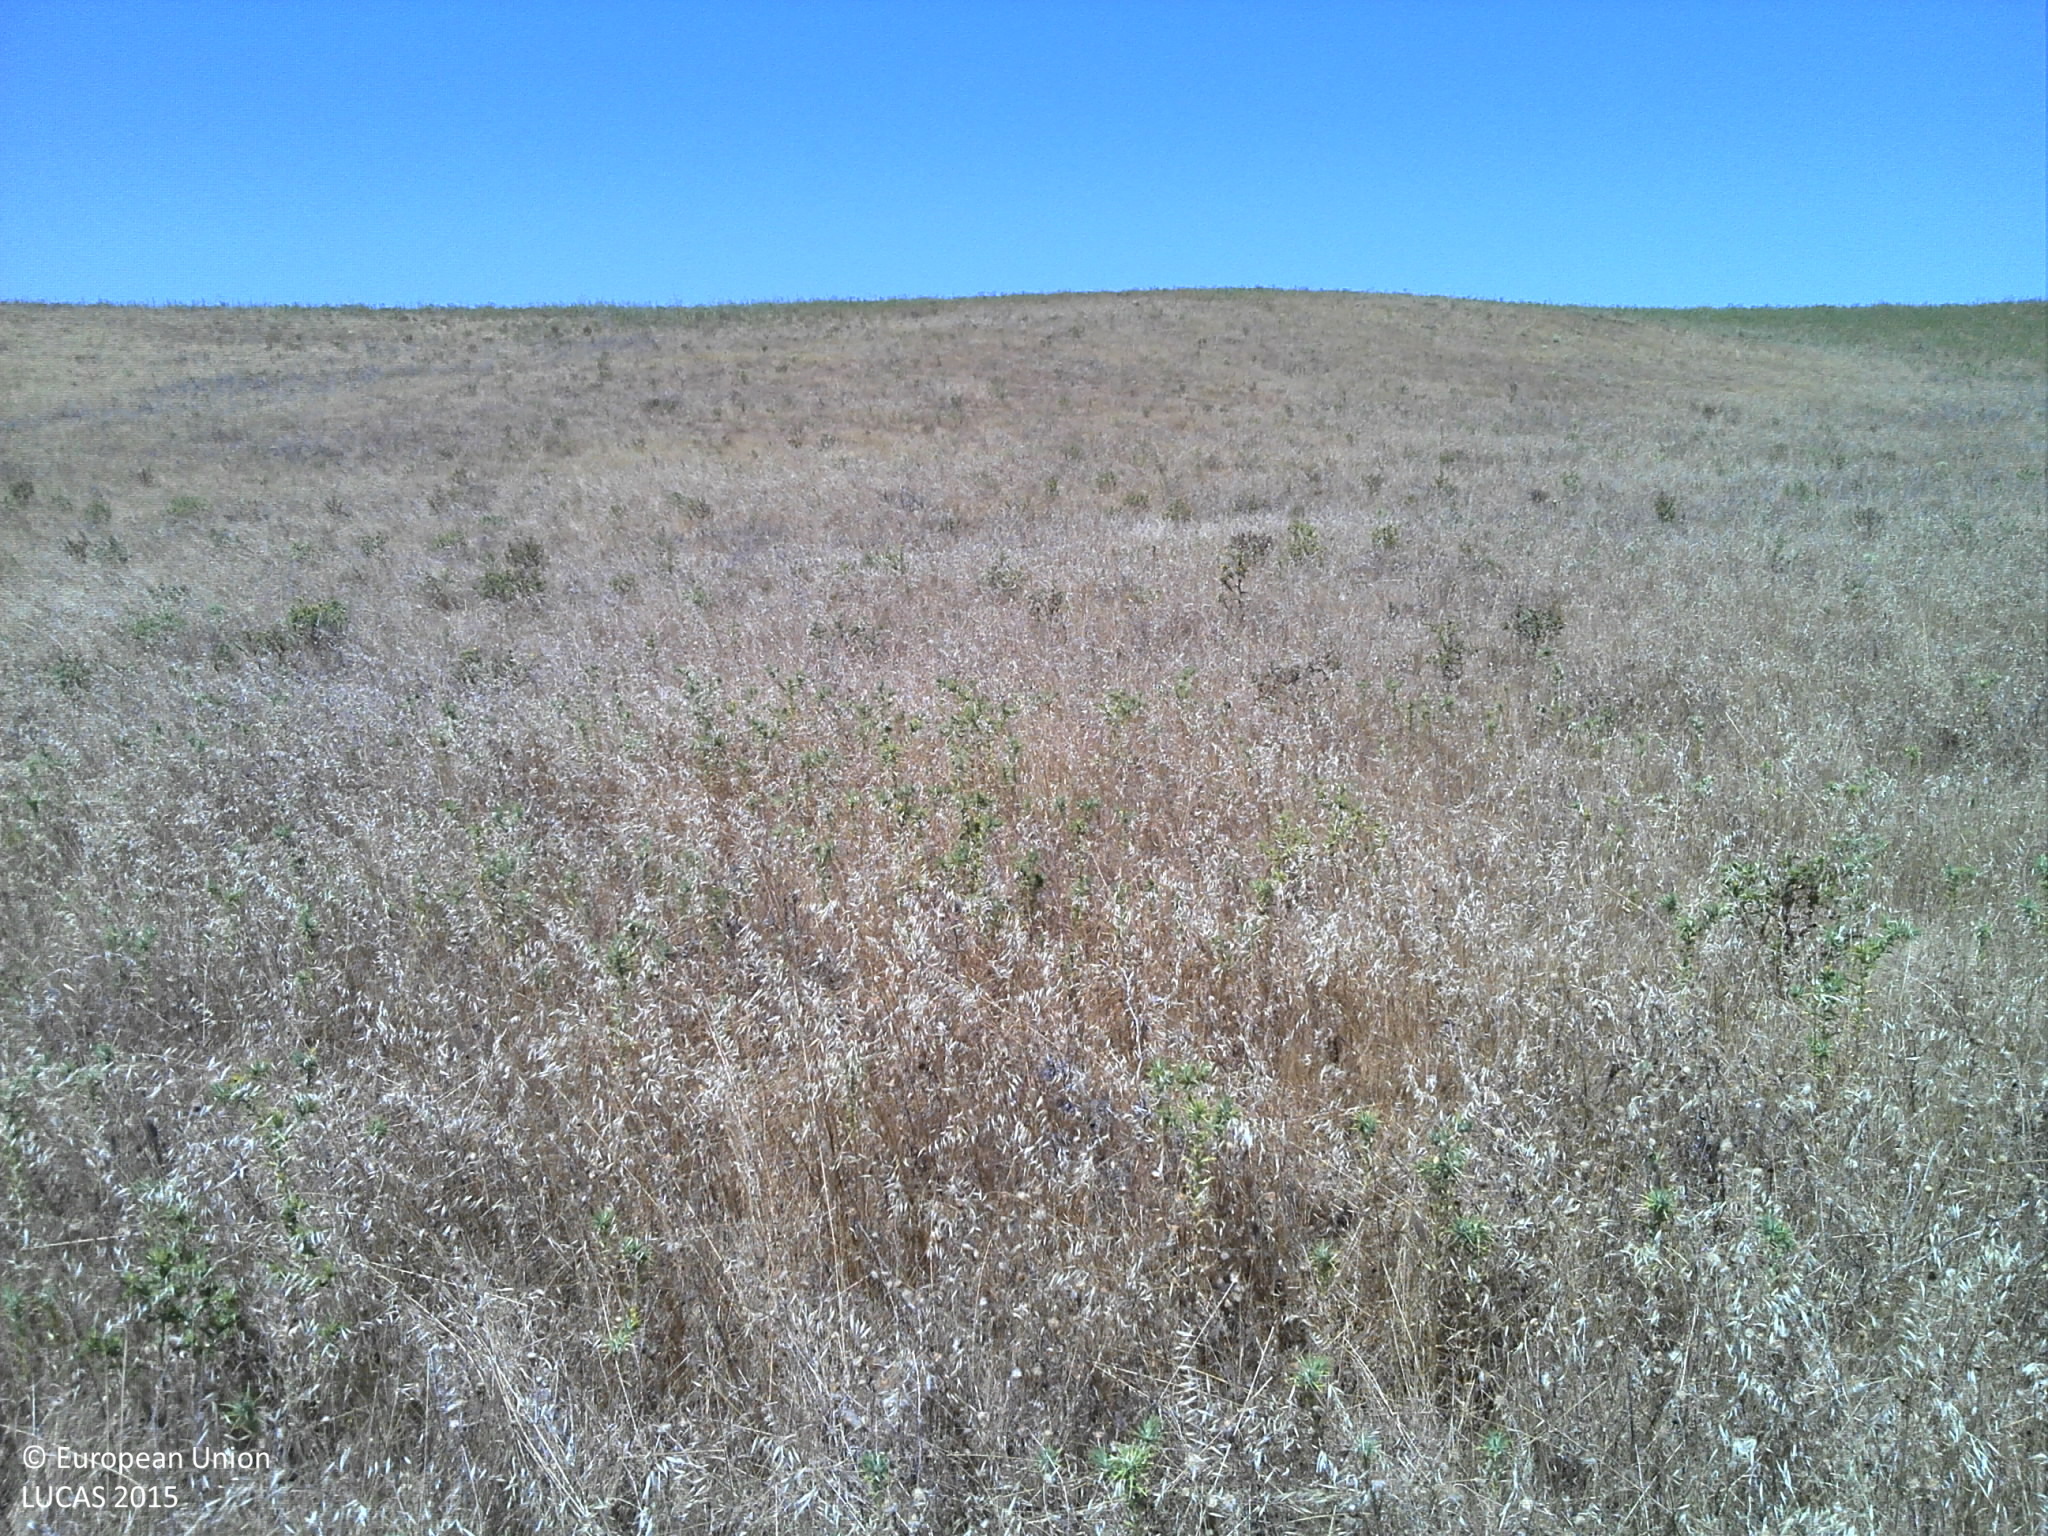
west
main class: Grassland
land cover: Grassland without tree/shrub cover
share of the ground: 50 - 75 %
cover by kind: herbaceous plants 70 %, unconsolidated bare surface 30 %
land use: Agriculture (excluding fallow land and kitchen gardens)
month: June
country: PT
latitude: 37.7883
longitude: -8.3045
